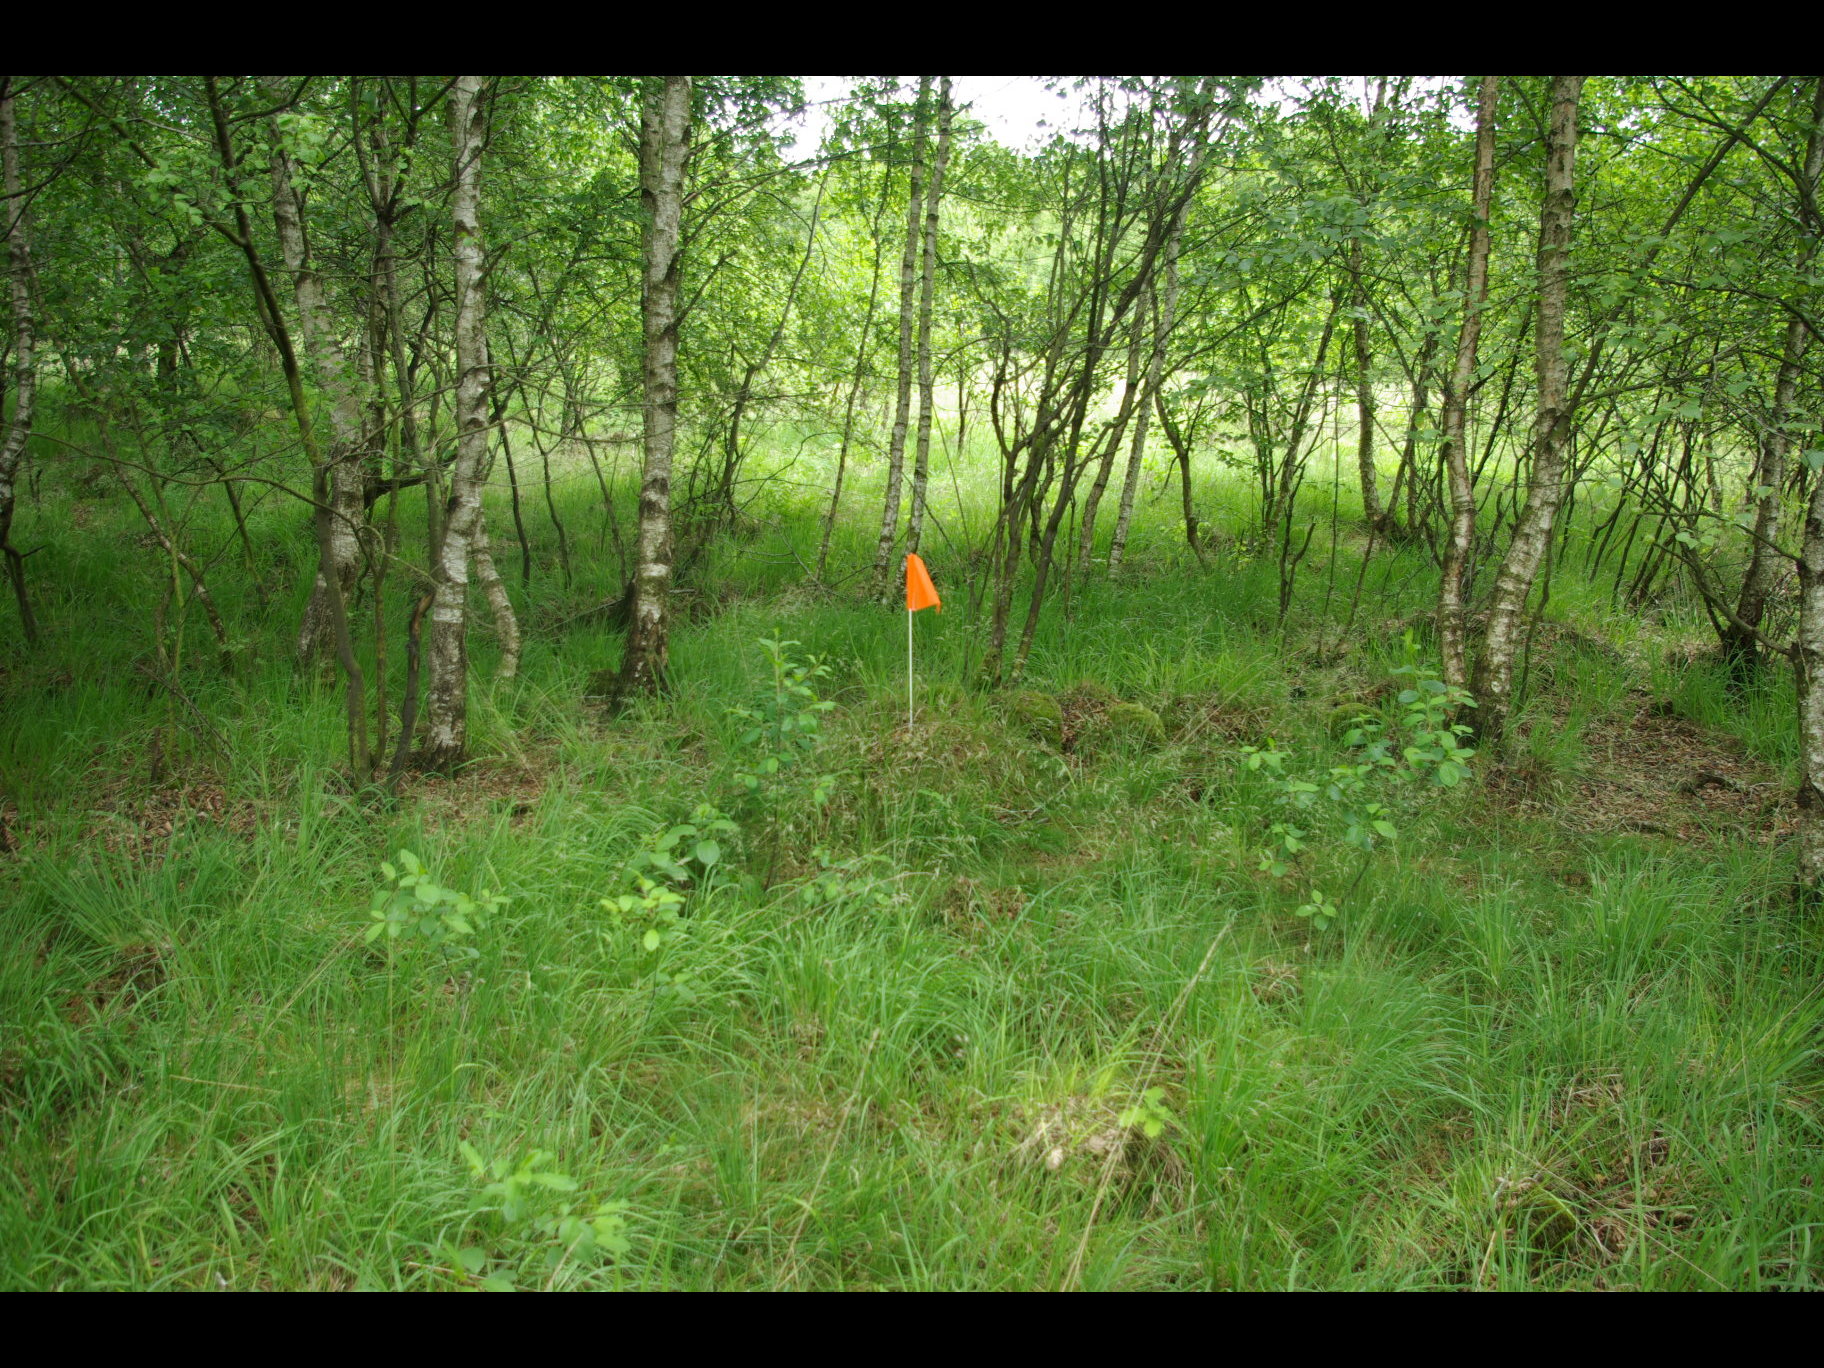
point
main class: Woodland
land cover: Broadleaved woodland
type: mire and swamp forests
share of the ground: > 75 %
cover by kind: broadleaved forest trees 70 %, herbaceous plants 20 %, lichens and mosses 10 %
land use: Semi-natural and natural areas not in use
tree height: < 5 m
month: June
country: DE
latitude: 54.1567
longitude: 9.9541
